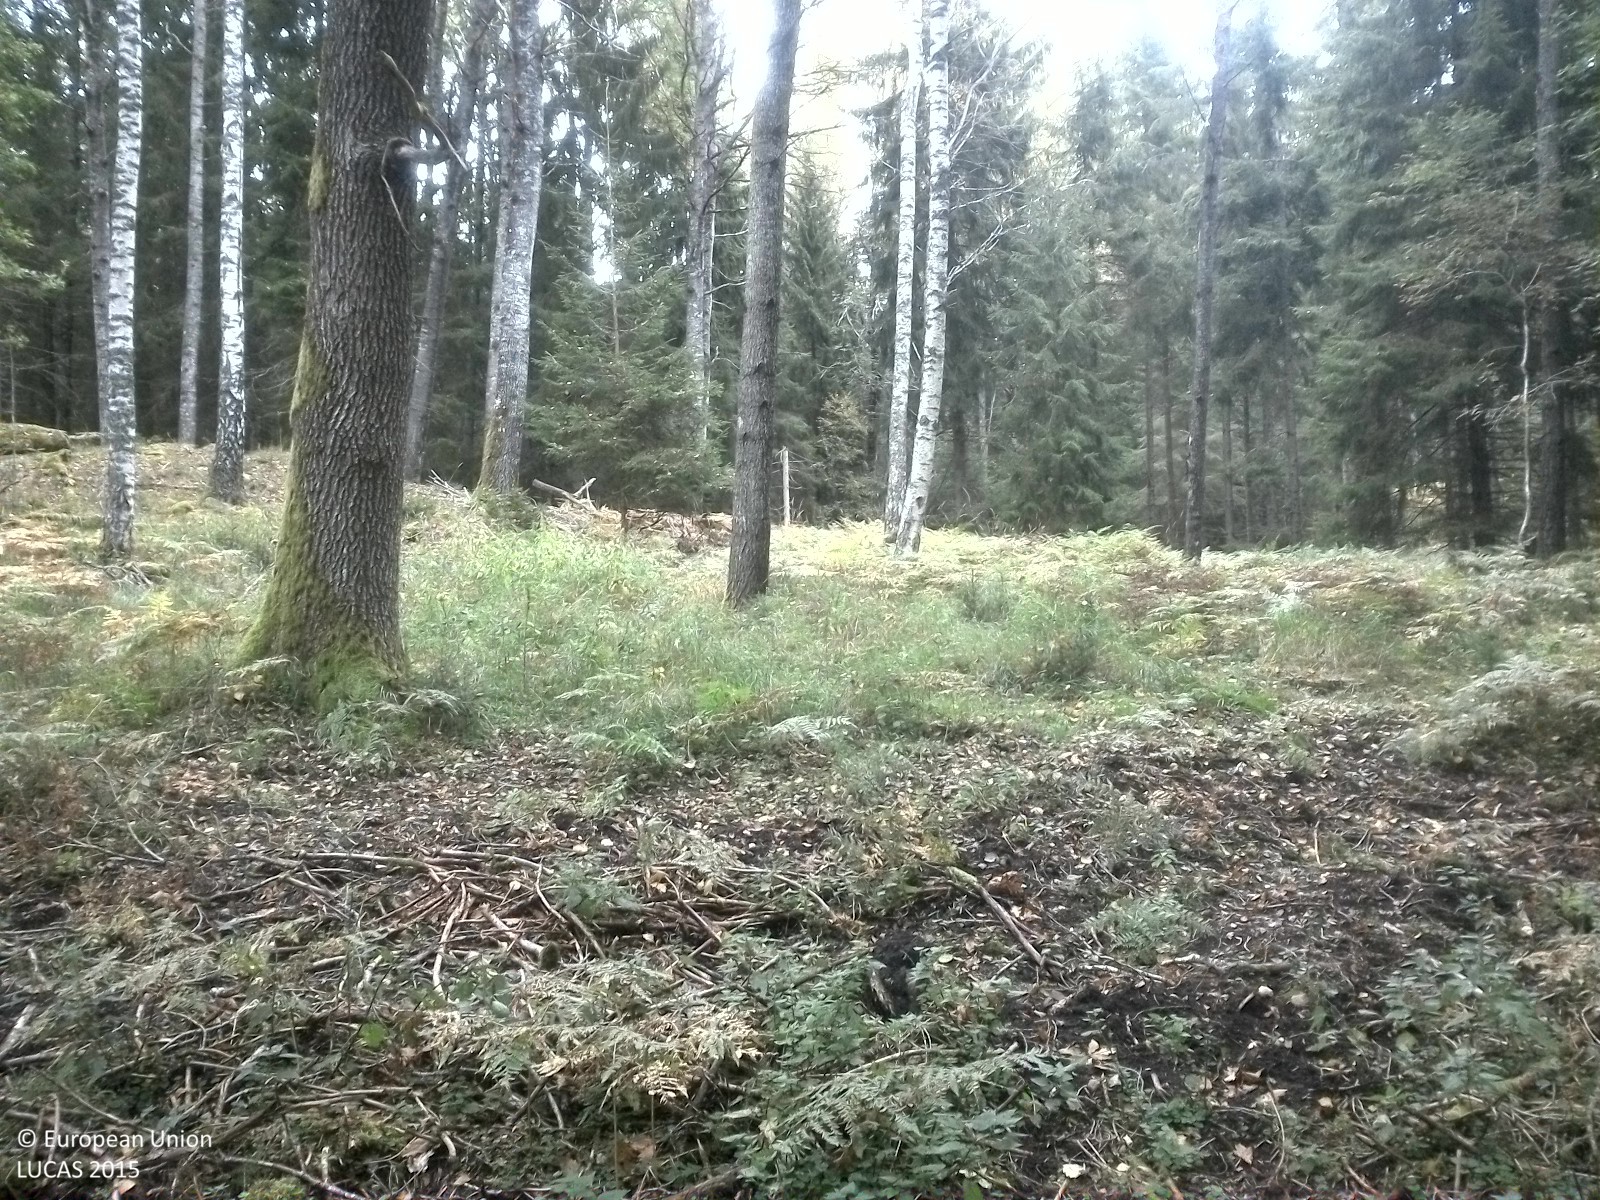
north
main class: Woodland
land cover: Spruce dominated coniferous woodland
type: boreal forest
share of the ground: 50 - 75 %
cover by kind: coniferous forest trees 60 %, lichens and mosses 20 %, herbaceous plants 10 %, unconsolidated bare surface 10 %
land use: Forestry
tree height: > 5 m
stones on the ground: < 10 %
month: September
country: SE
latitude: 58.9073
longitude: 15.7744
